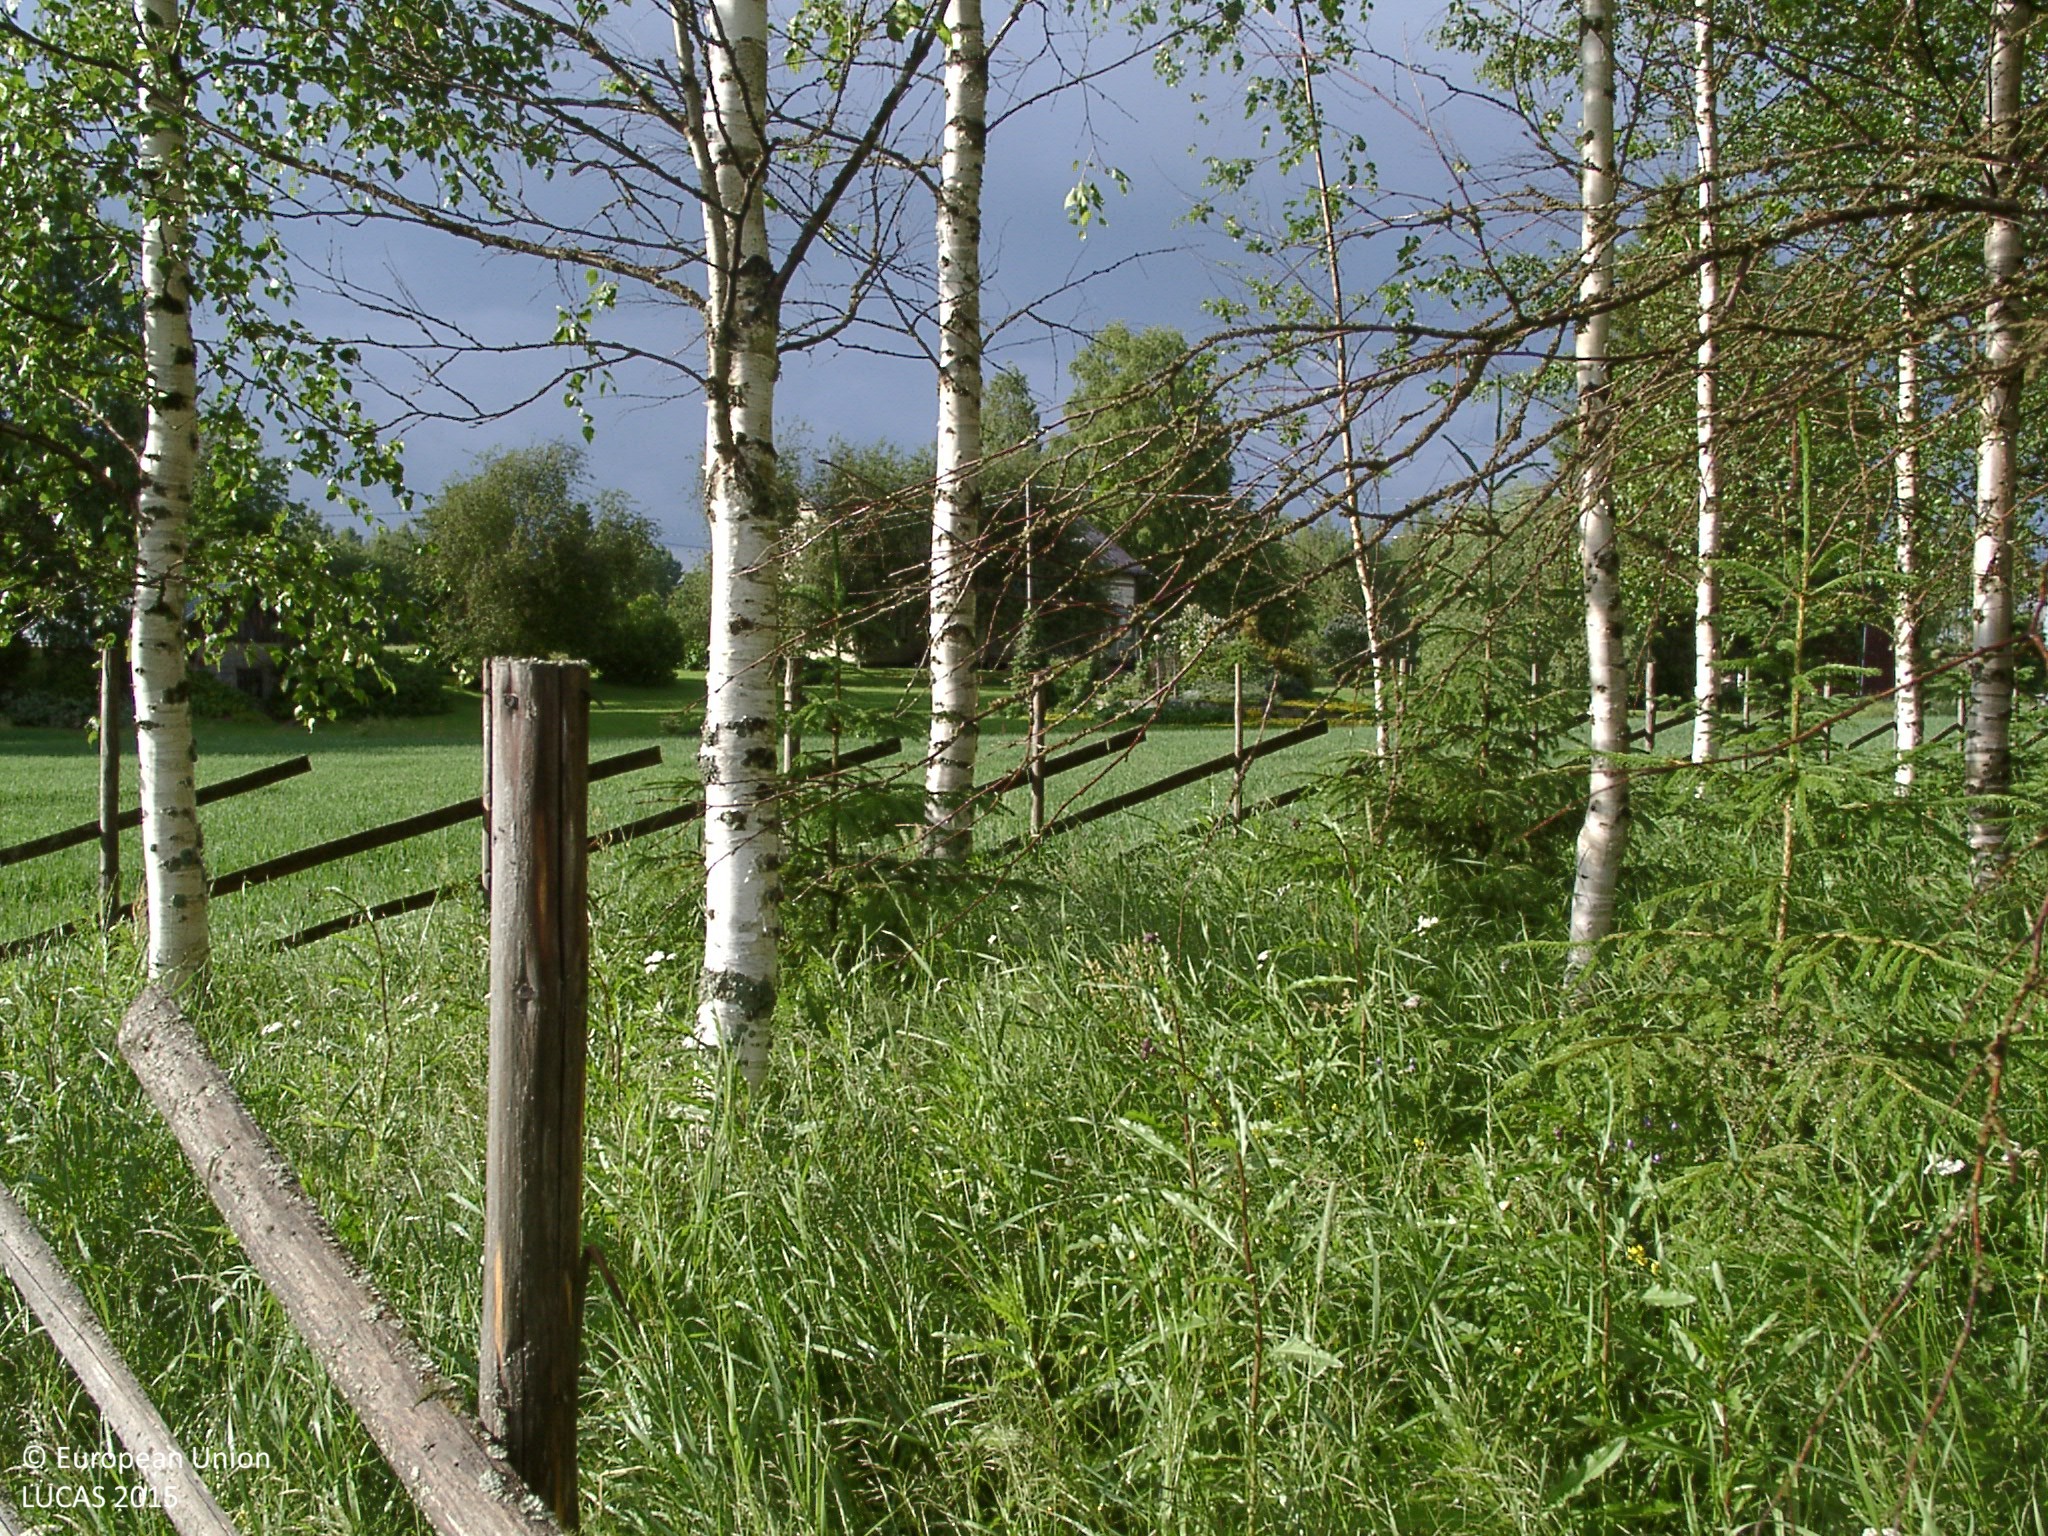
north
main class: Cropland
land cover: Oats
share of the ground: > 75 %
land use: Agriculture (excluding fallow land and kitchen gardens)
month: July
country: FI
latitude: 62.2028
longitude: 25.1965
